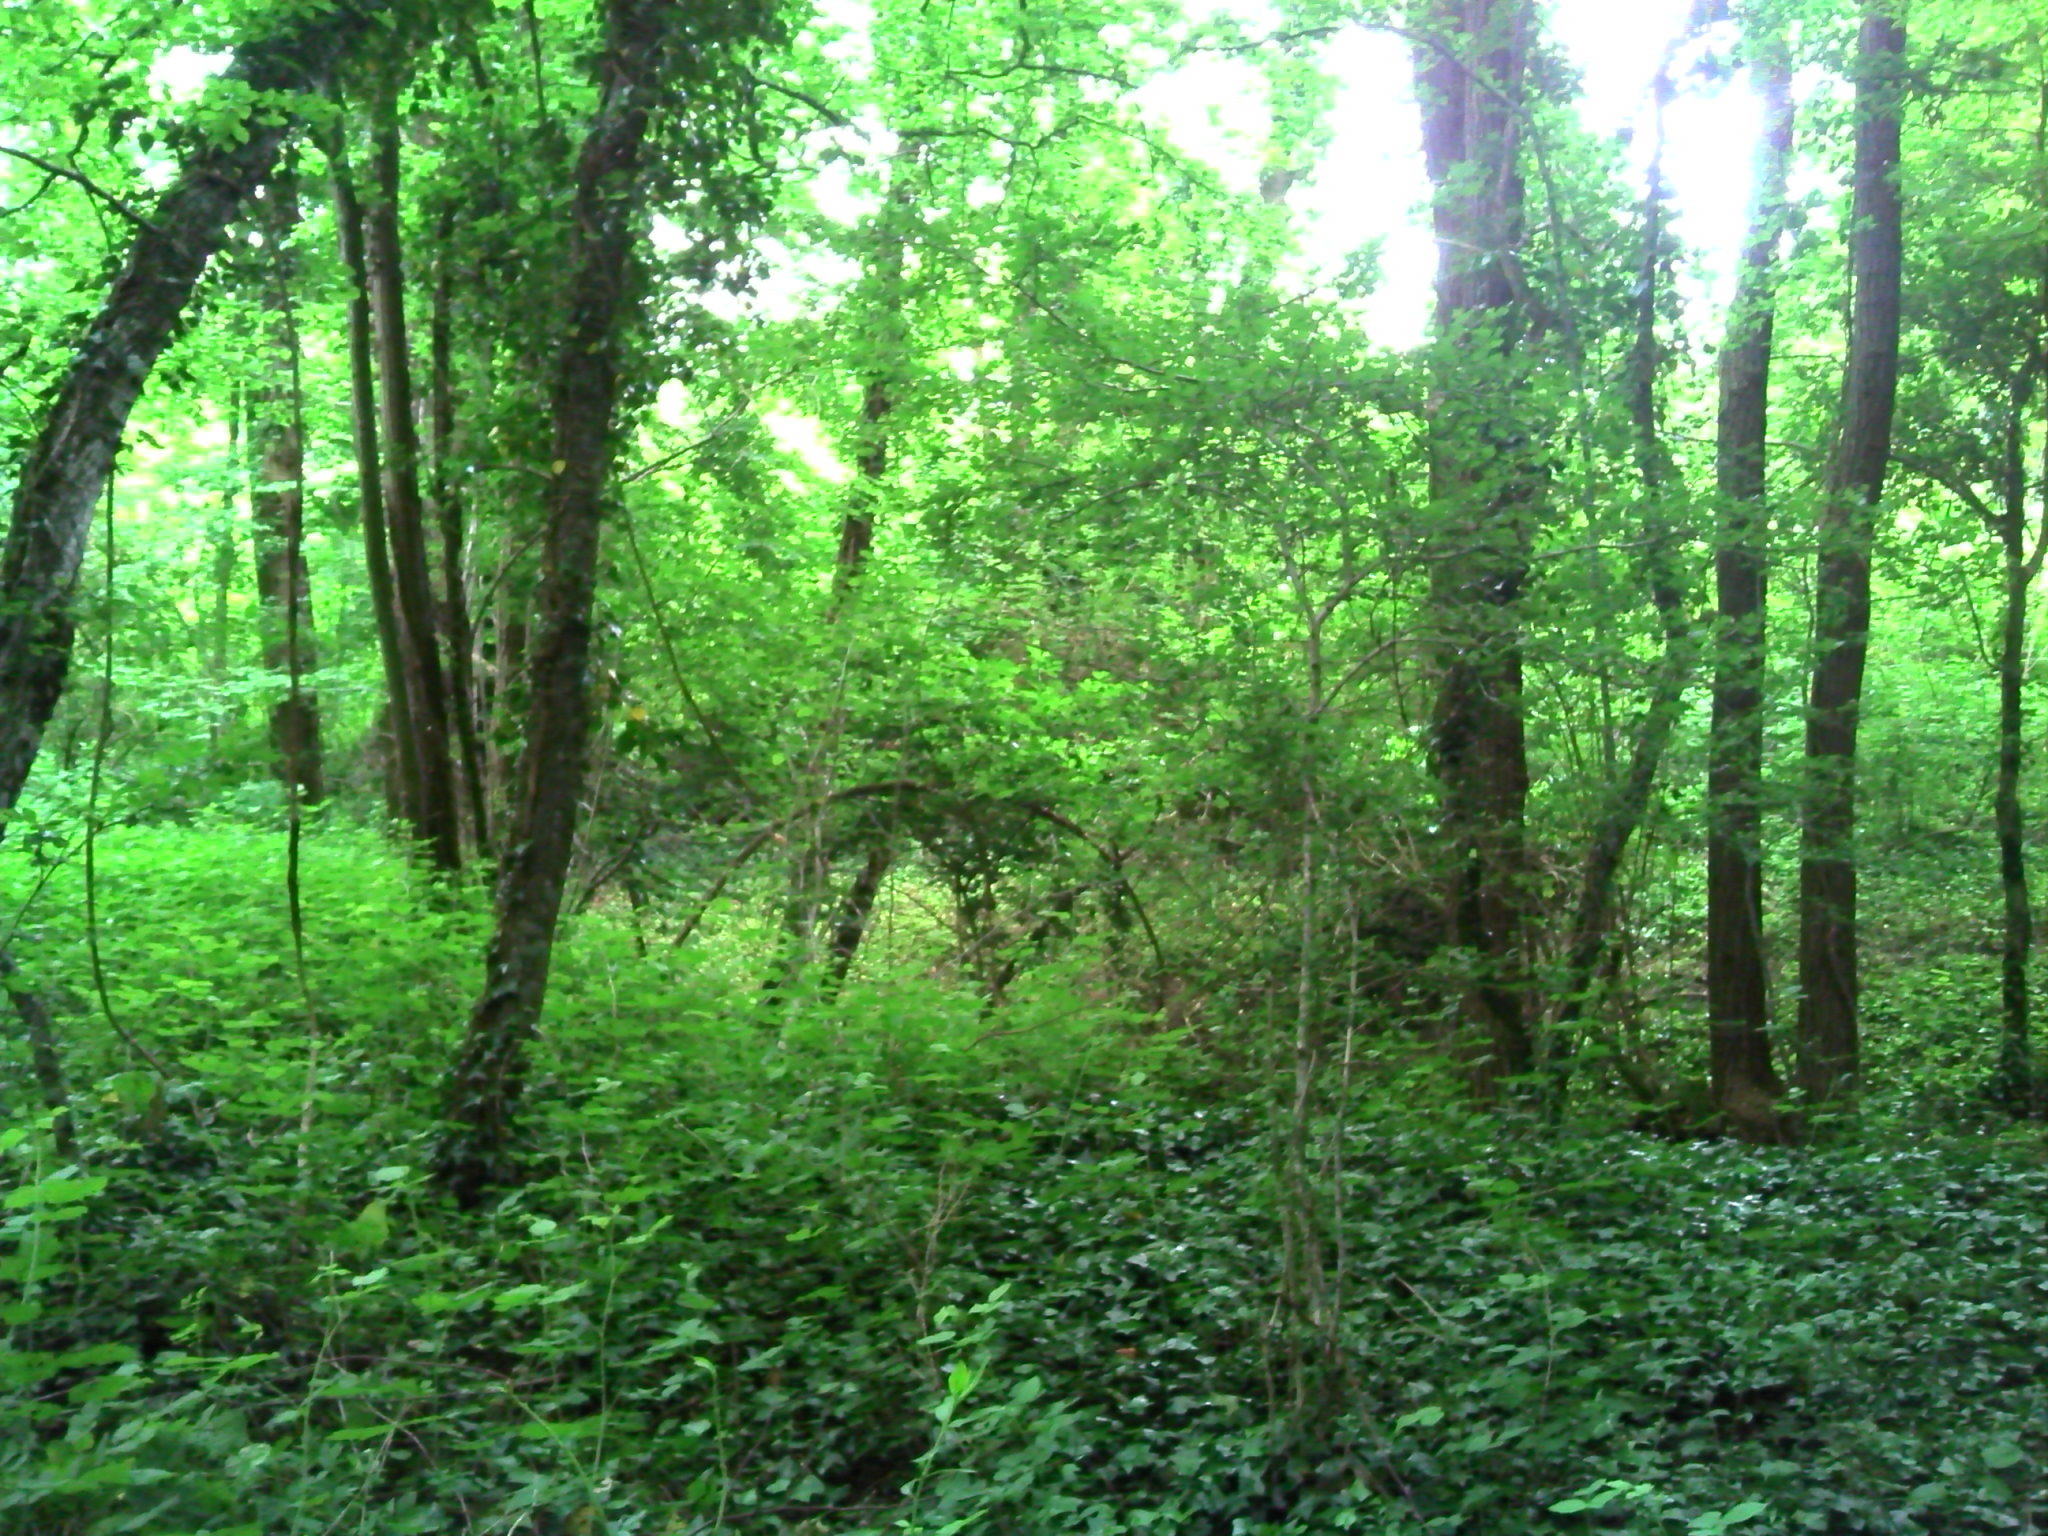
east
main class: Woodland
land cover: Broadleaved woodland
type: beech forest
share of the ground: > 75 %
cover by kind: broadleaved forest trees 100 %
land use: Forestry
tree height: > 5 m
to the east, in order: Broadleaved woodland; Grassland with sparse tree/shrub cover; Broadleaved woodland; Fences; Ditches and canals; Artificial constructions in urban areas; Single bushes/trees; Grassland without tree/shrub cover; Broadleaved woodland
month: May
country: FR
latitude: 47.5027
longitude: 2.8378
